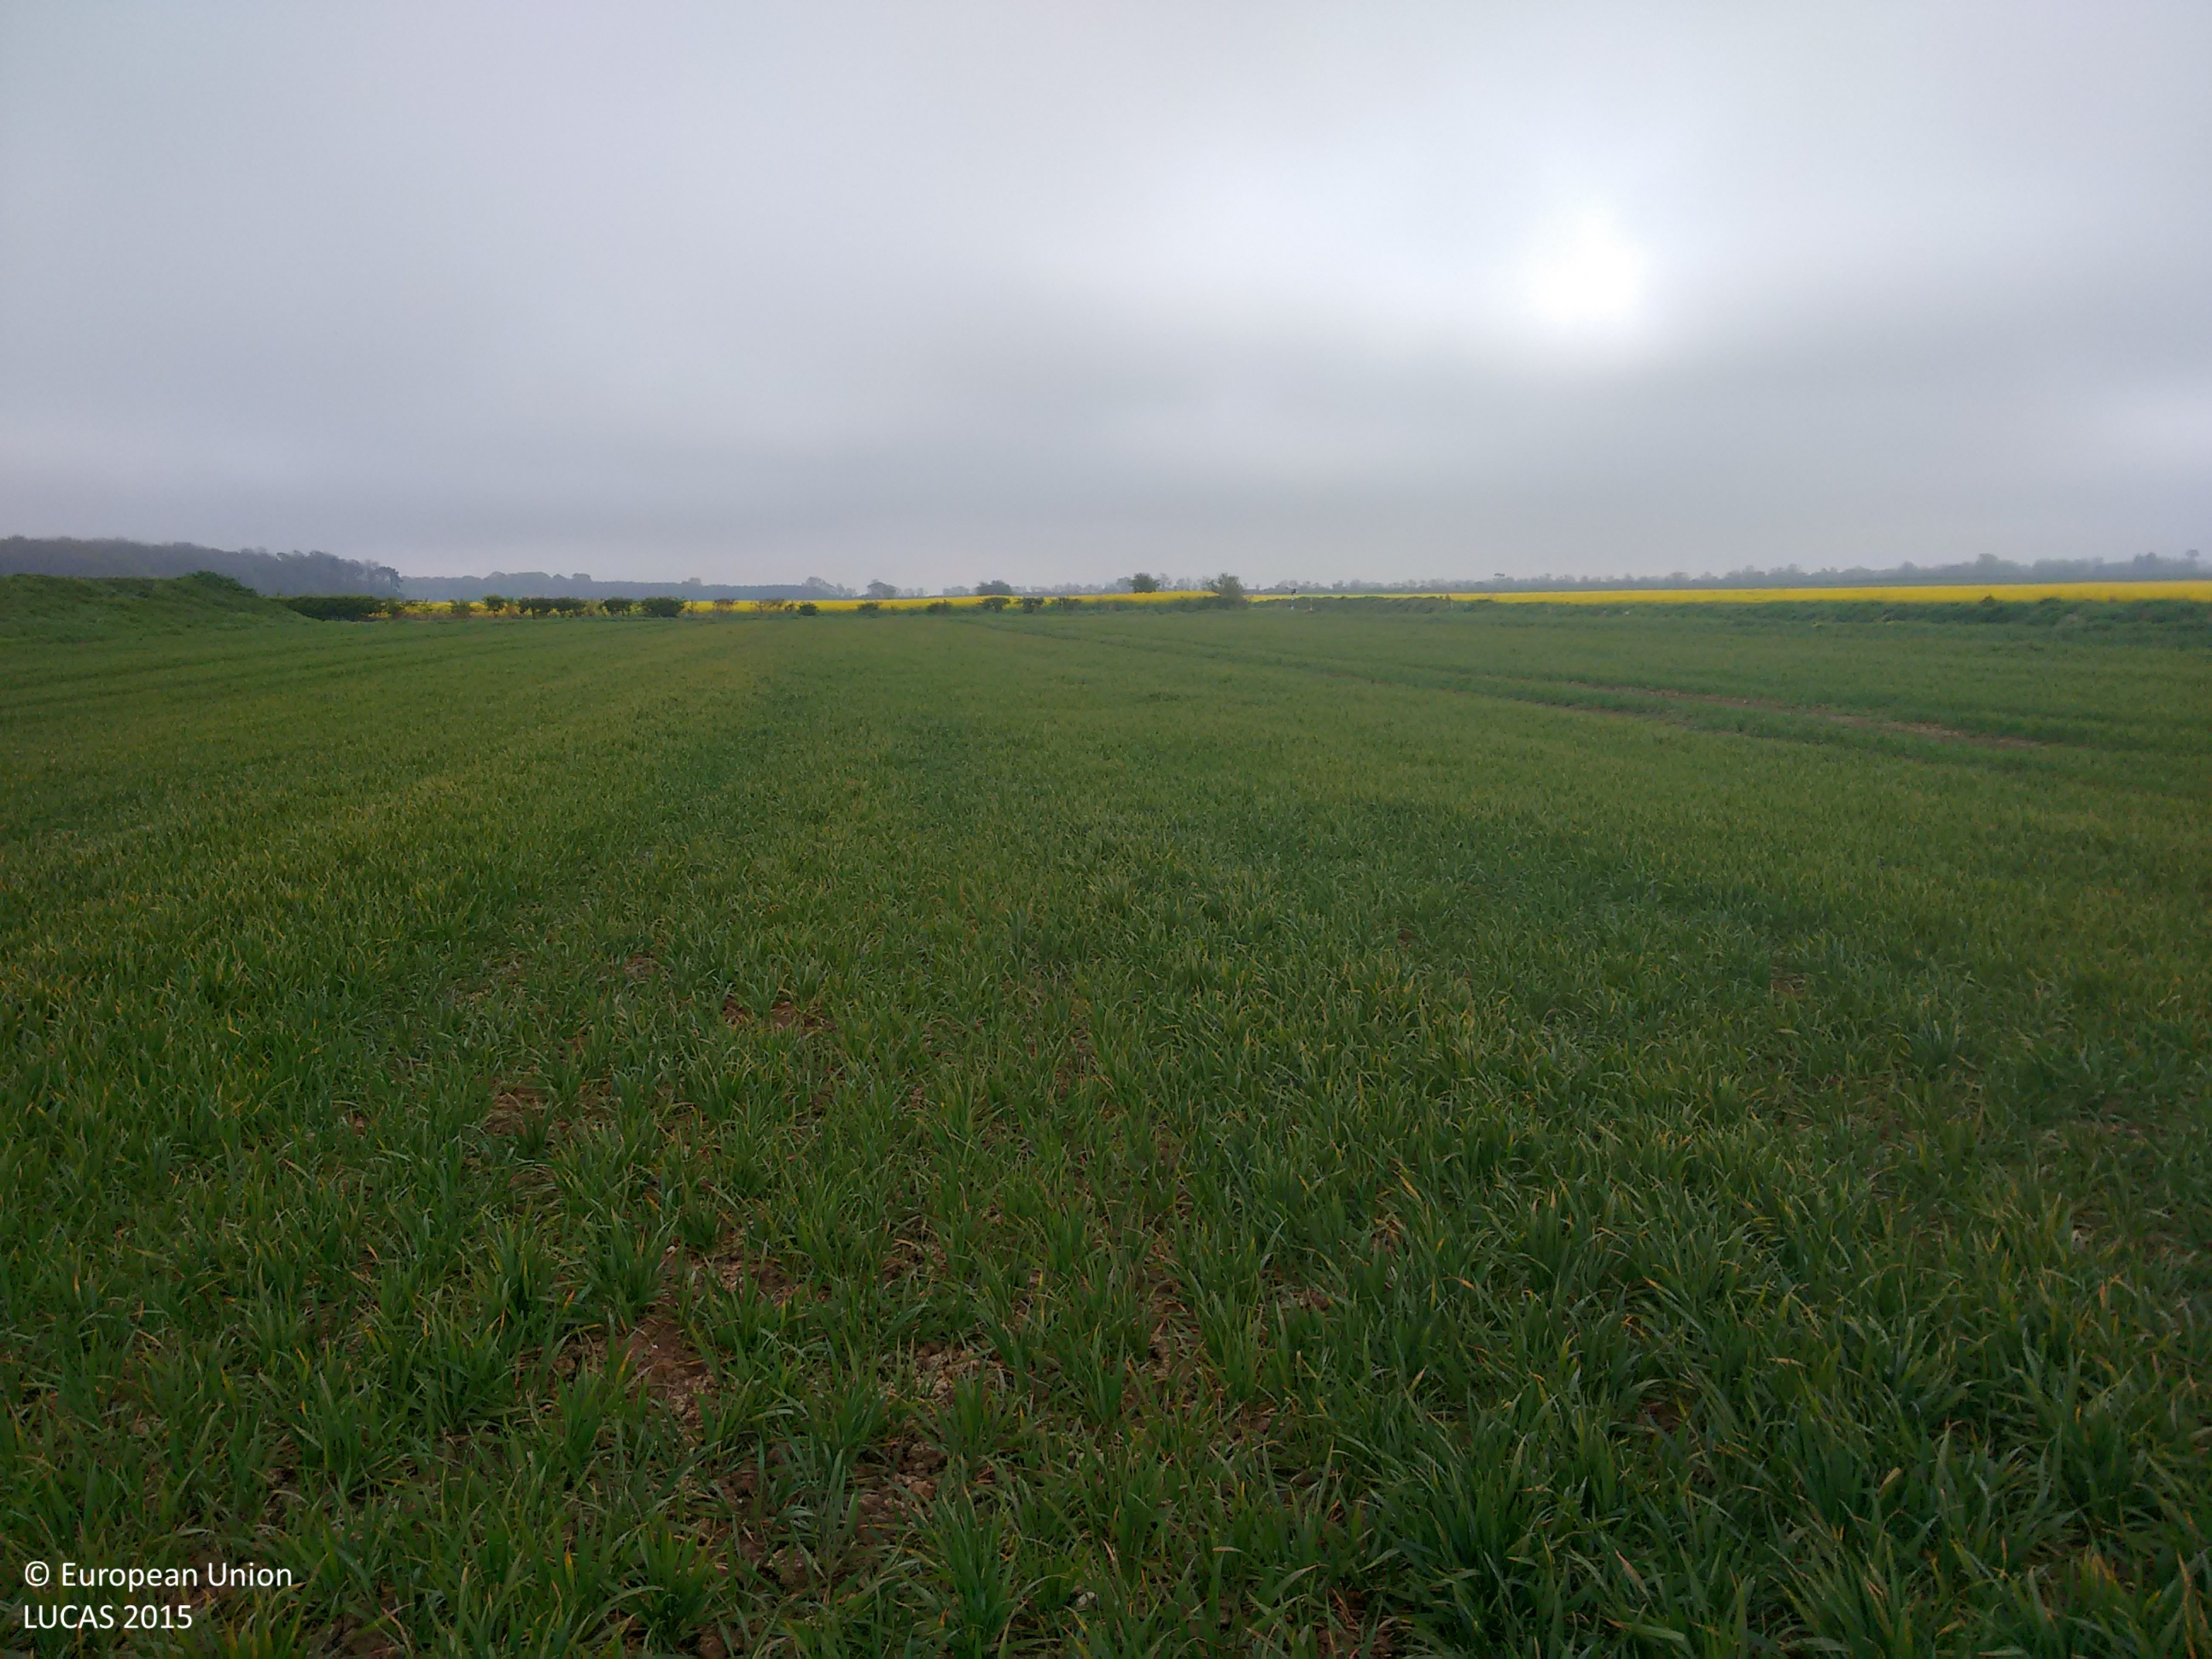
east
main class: Cropland
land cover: Common wheat
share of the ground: > 75 %
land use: Agriculture (excluding fallow land and kitchen gardens)
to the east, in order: Common wheat; Grass margins; Rivers and streams; Grassland without tree/shrub cover; Common wheat; Rape and turnip rape
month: May
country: GB
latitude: 53.9772
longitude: -0.2957
